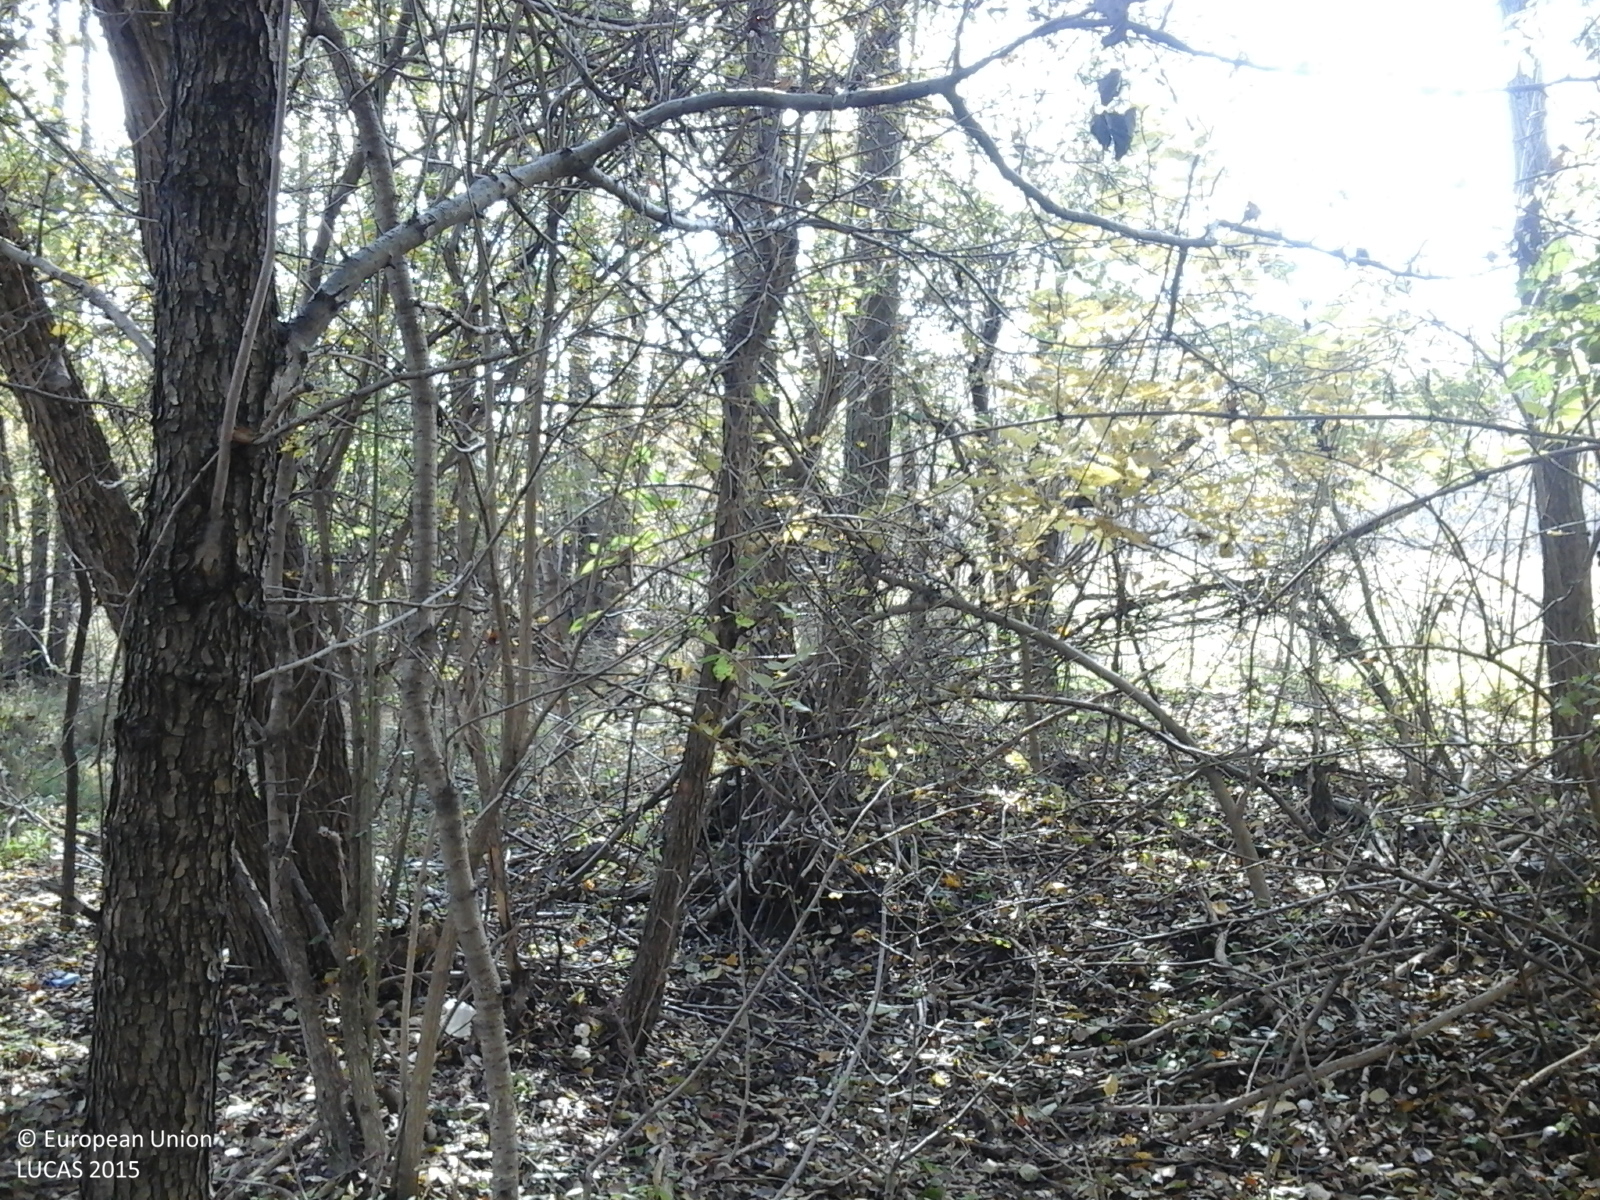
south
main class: Woodland
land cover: Broadleaved woodland
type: non-riverine alder, birch or aspen forest
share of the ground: > 75 %
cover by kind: broadleaved forest trees 100 %
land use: Forestry
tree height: > 5 m
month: October
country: RO
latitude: 45.9555
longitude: 26.9799
